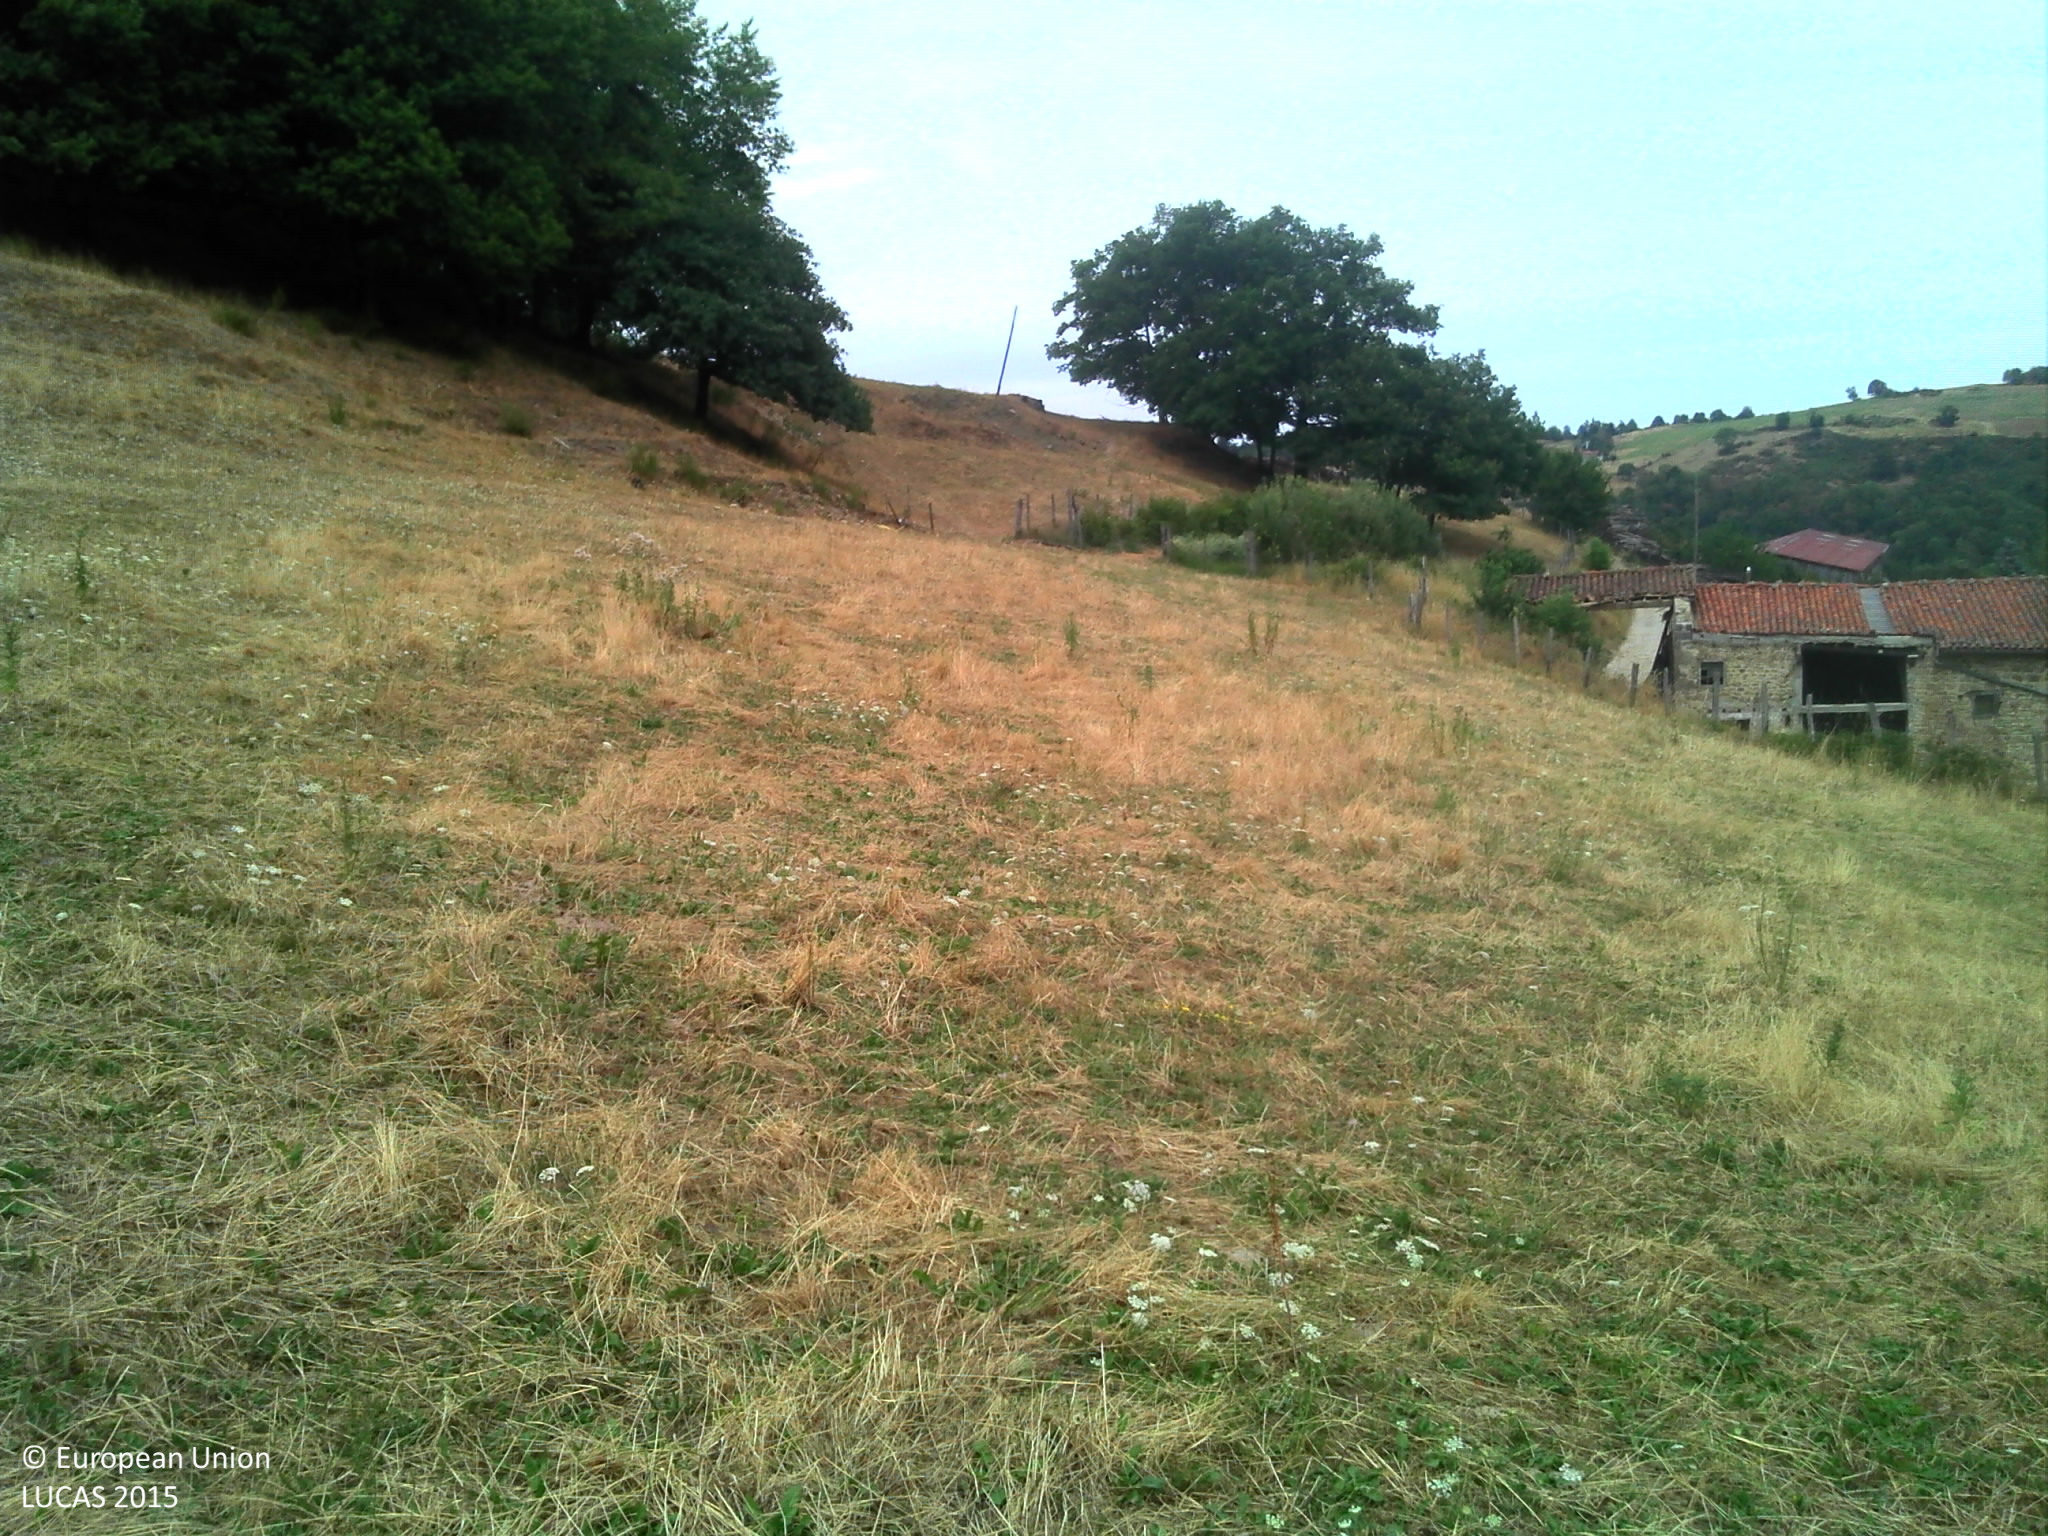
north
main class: Grassland
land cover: Grassland without tree/shrub cover
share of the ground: > 75 %
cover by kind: herbaceous plants 100 %
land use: Agriculture (excluding fallow land and kitchen gardens)
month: July
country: FR
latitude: 45.6859
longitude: 4.4950
